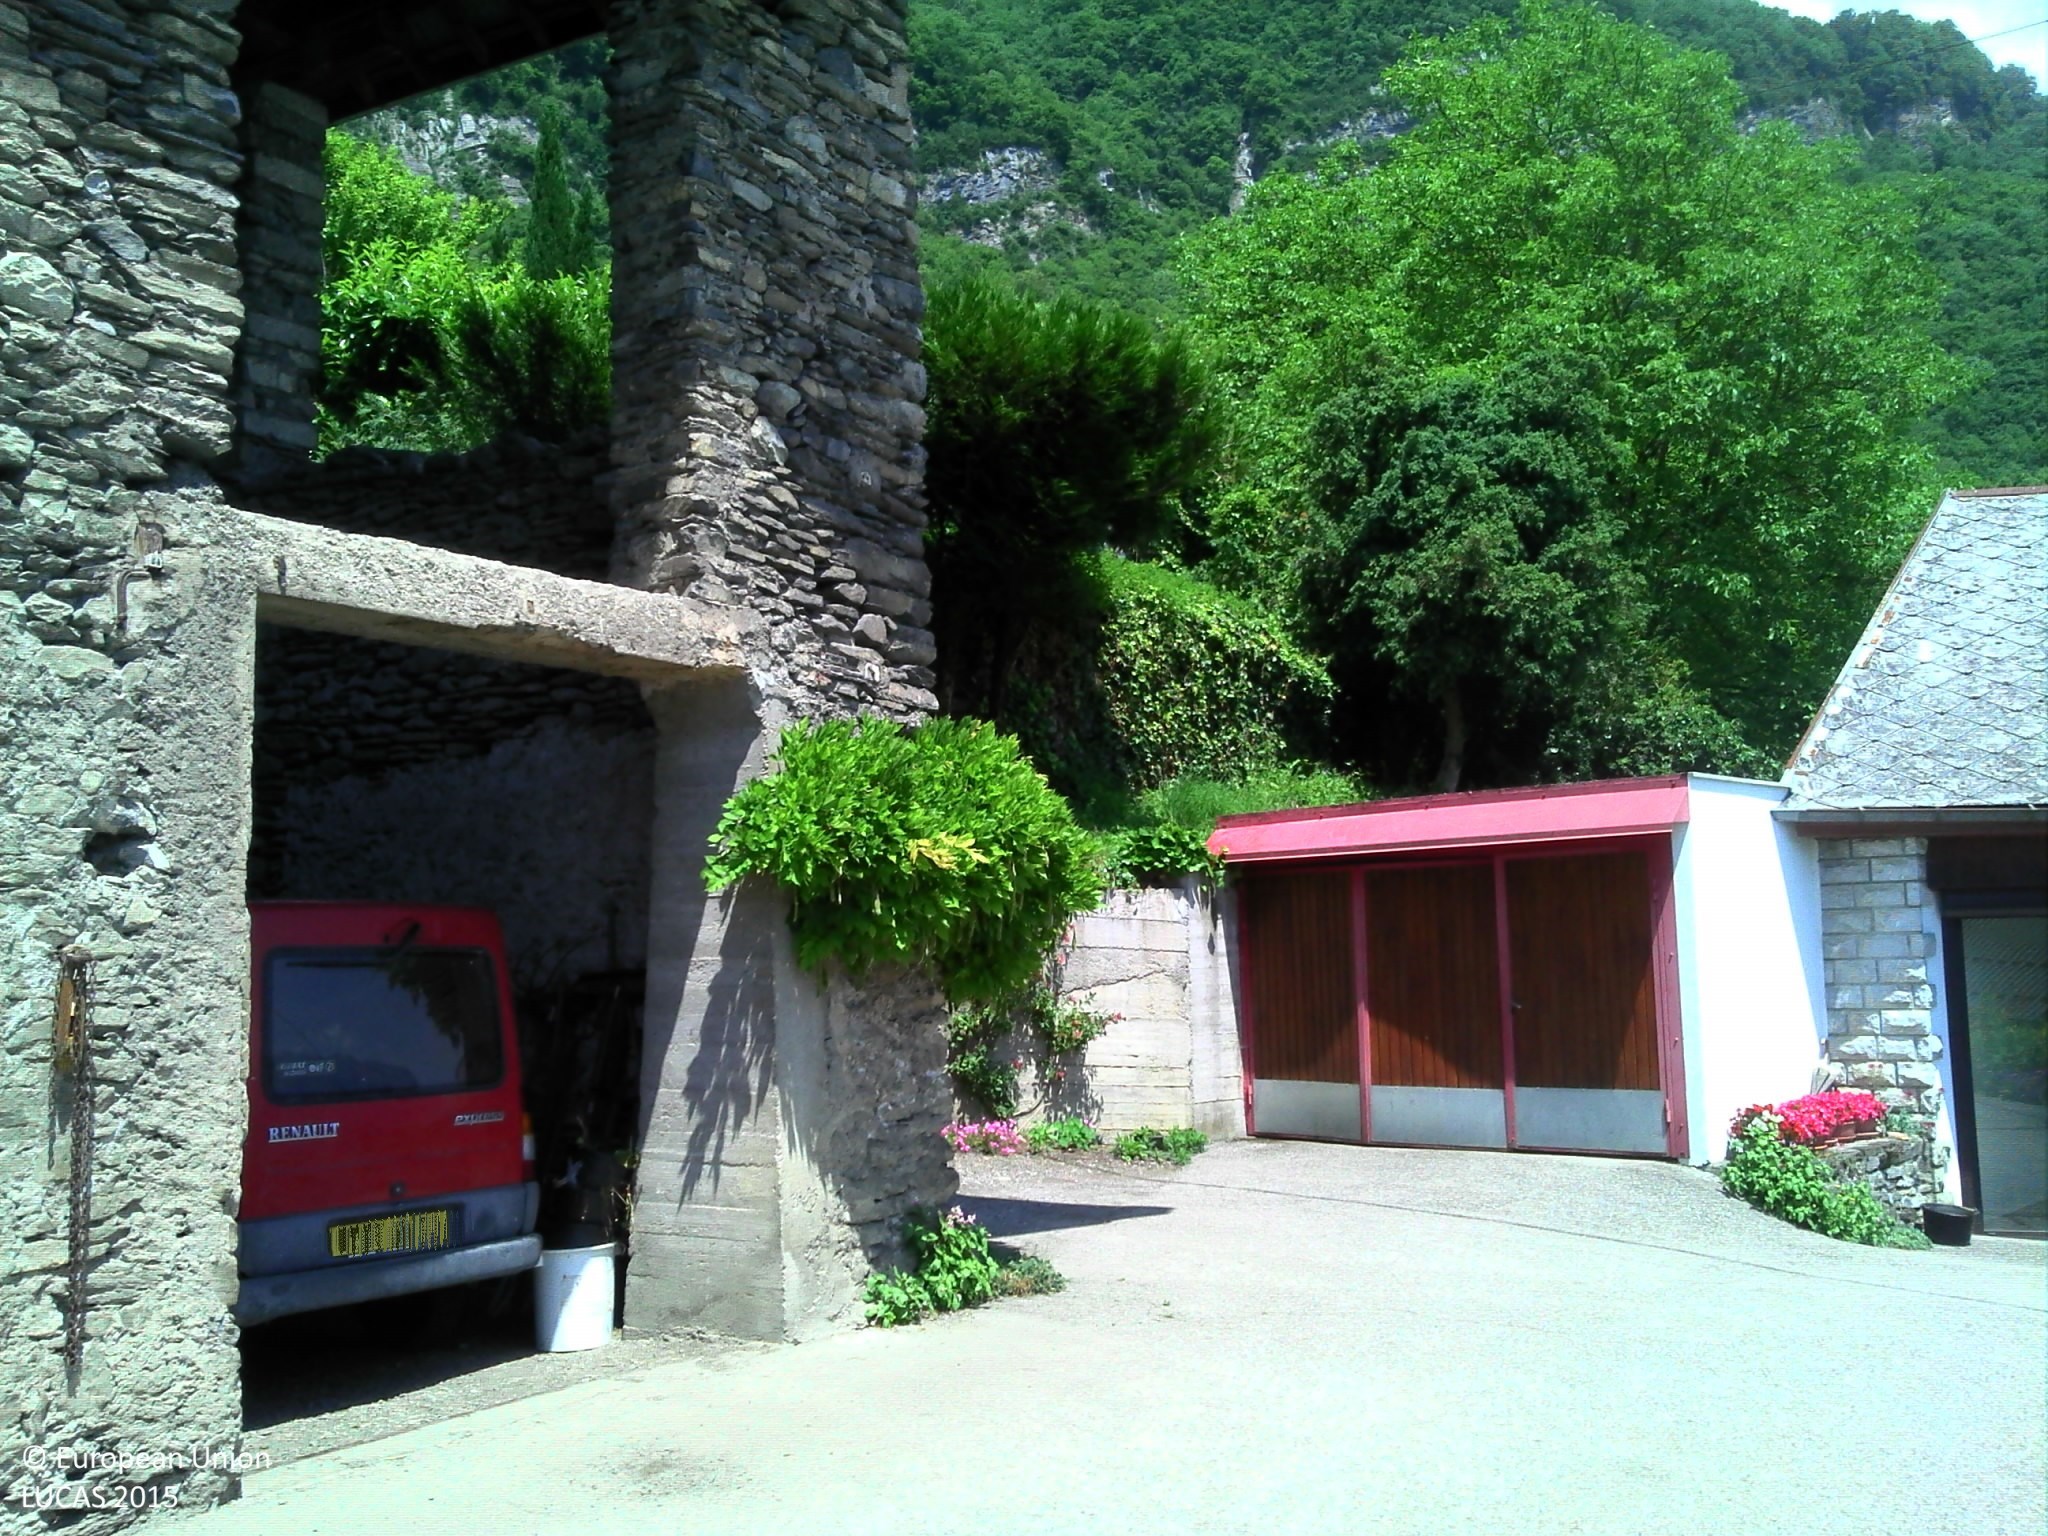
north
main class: Woodland
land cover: Broadleaved woodland
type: mountainous beech forest
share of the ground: > 75 %
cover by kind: broadleaved forest trees 100 %
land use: Forestry
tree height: > 5 m
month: June
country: FR
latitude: 45.5992
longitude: 6.2225
